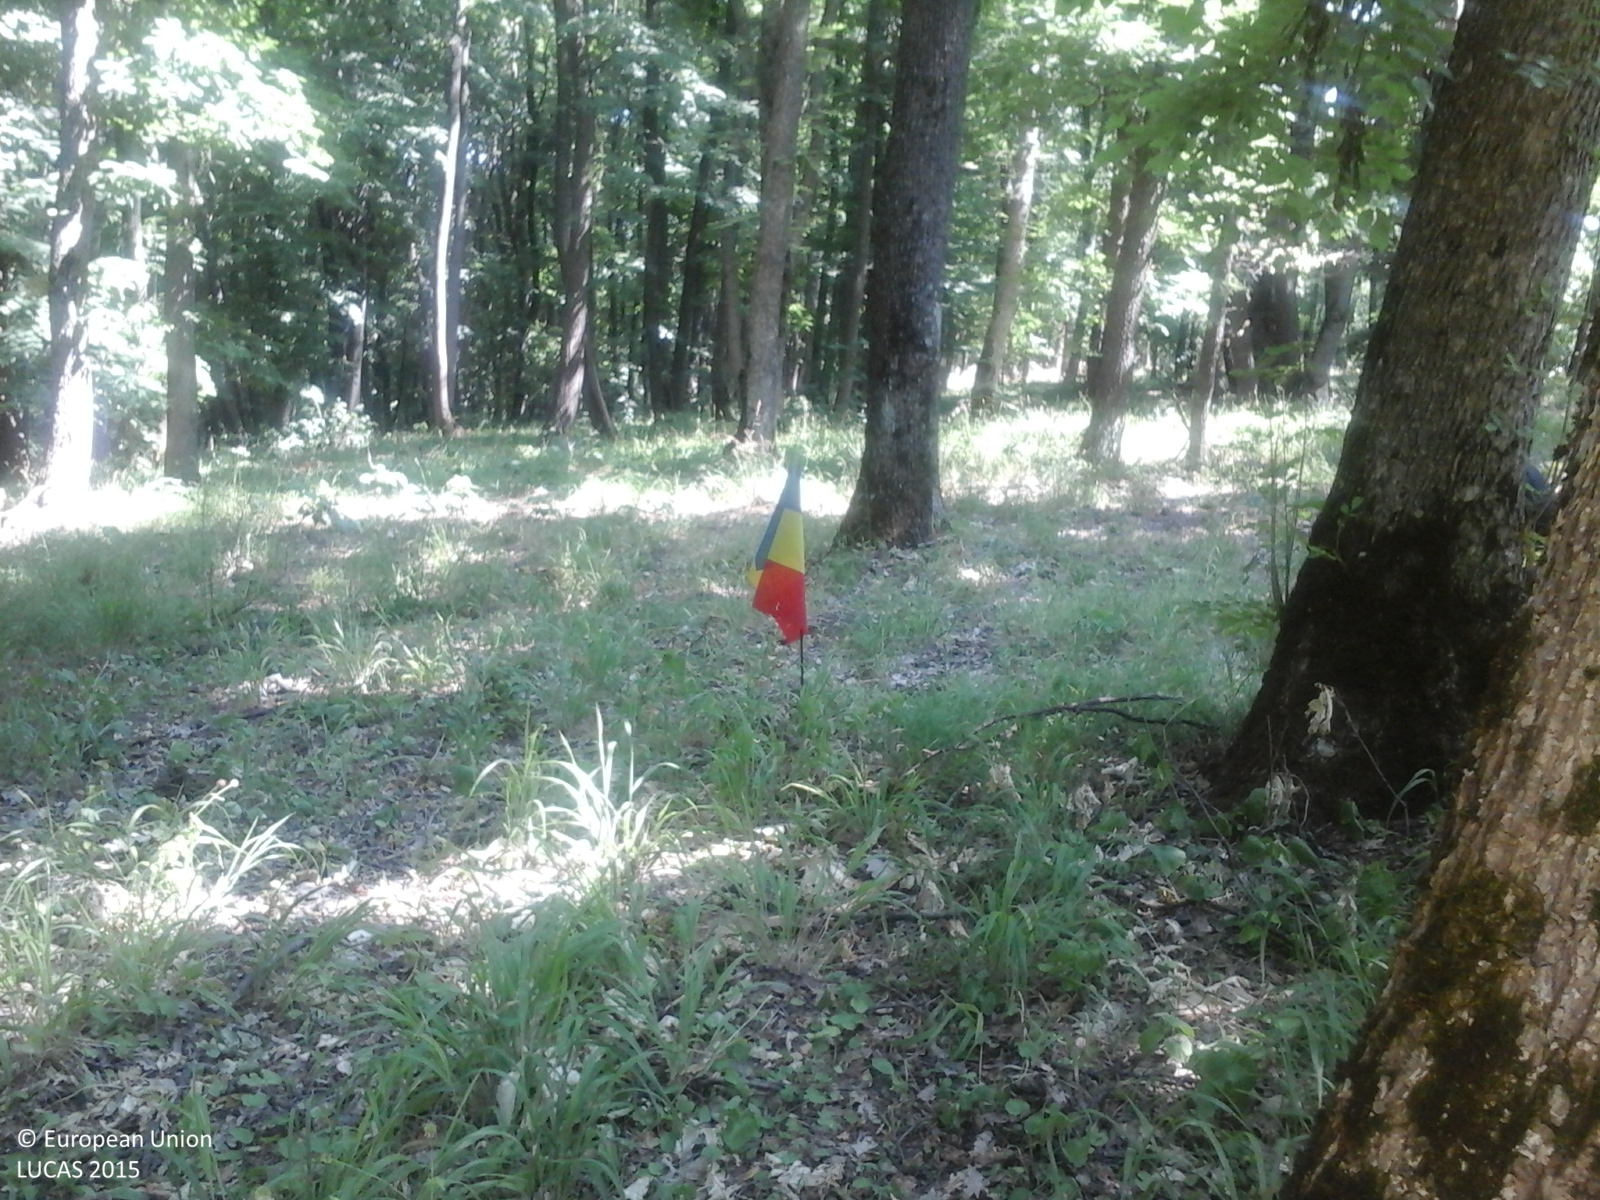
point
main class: Woodland
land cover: Broadleaved woodland
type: beech forest
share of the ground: > 75 %
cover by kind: broadleaved forest trees 85 %, herbaceous plants 15 %
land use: Forestry
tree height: > 5 m
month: June
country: RO
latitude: 46.8401
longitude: 27.8656
